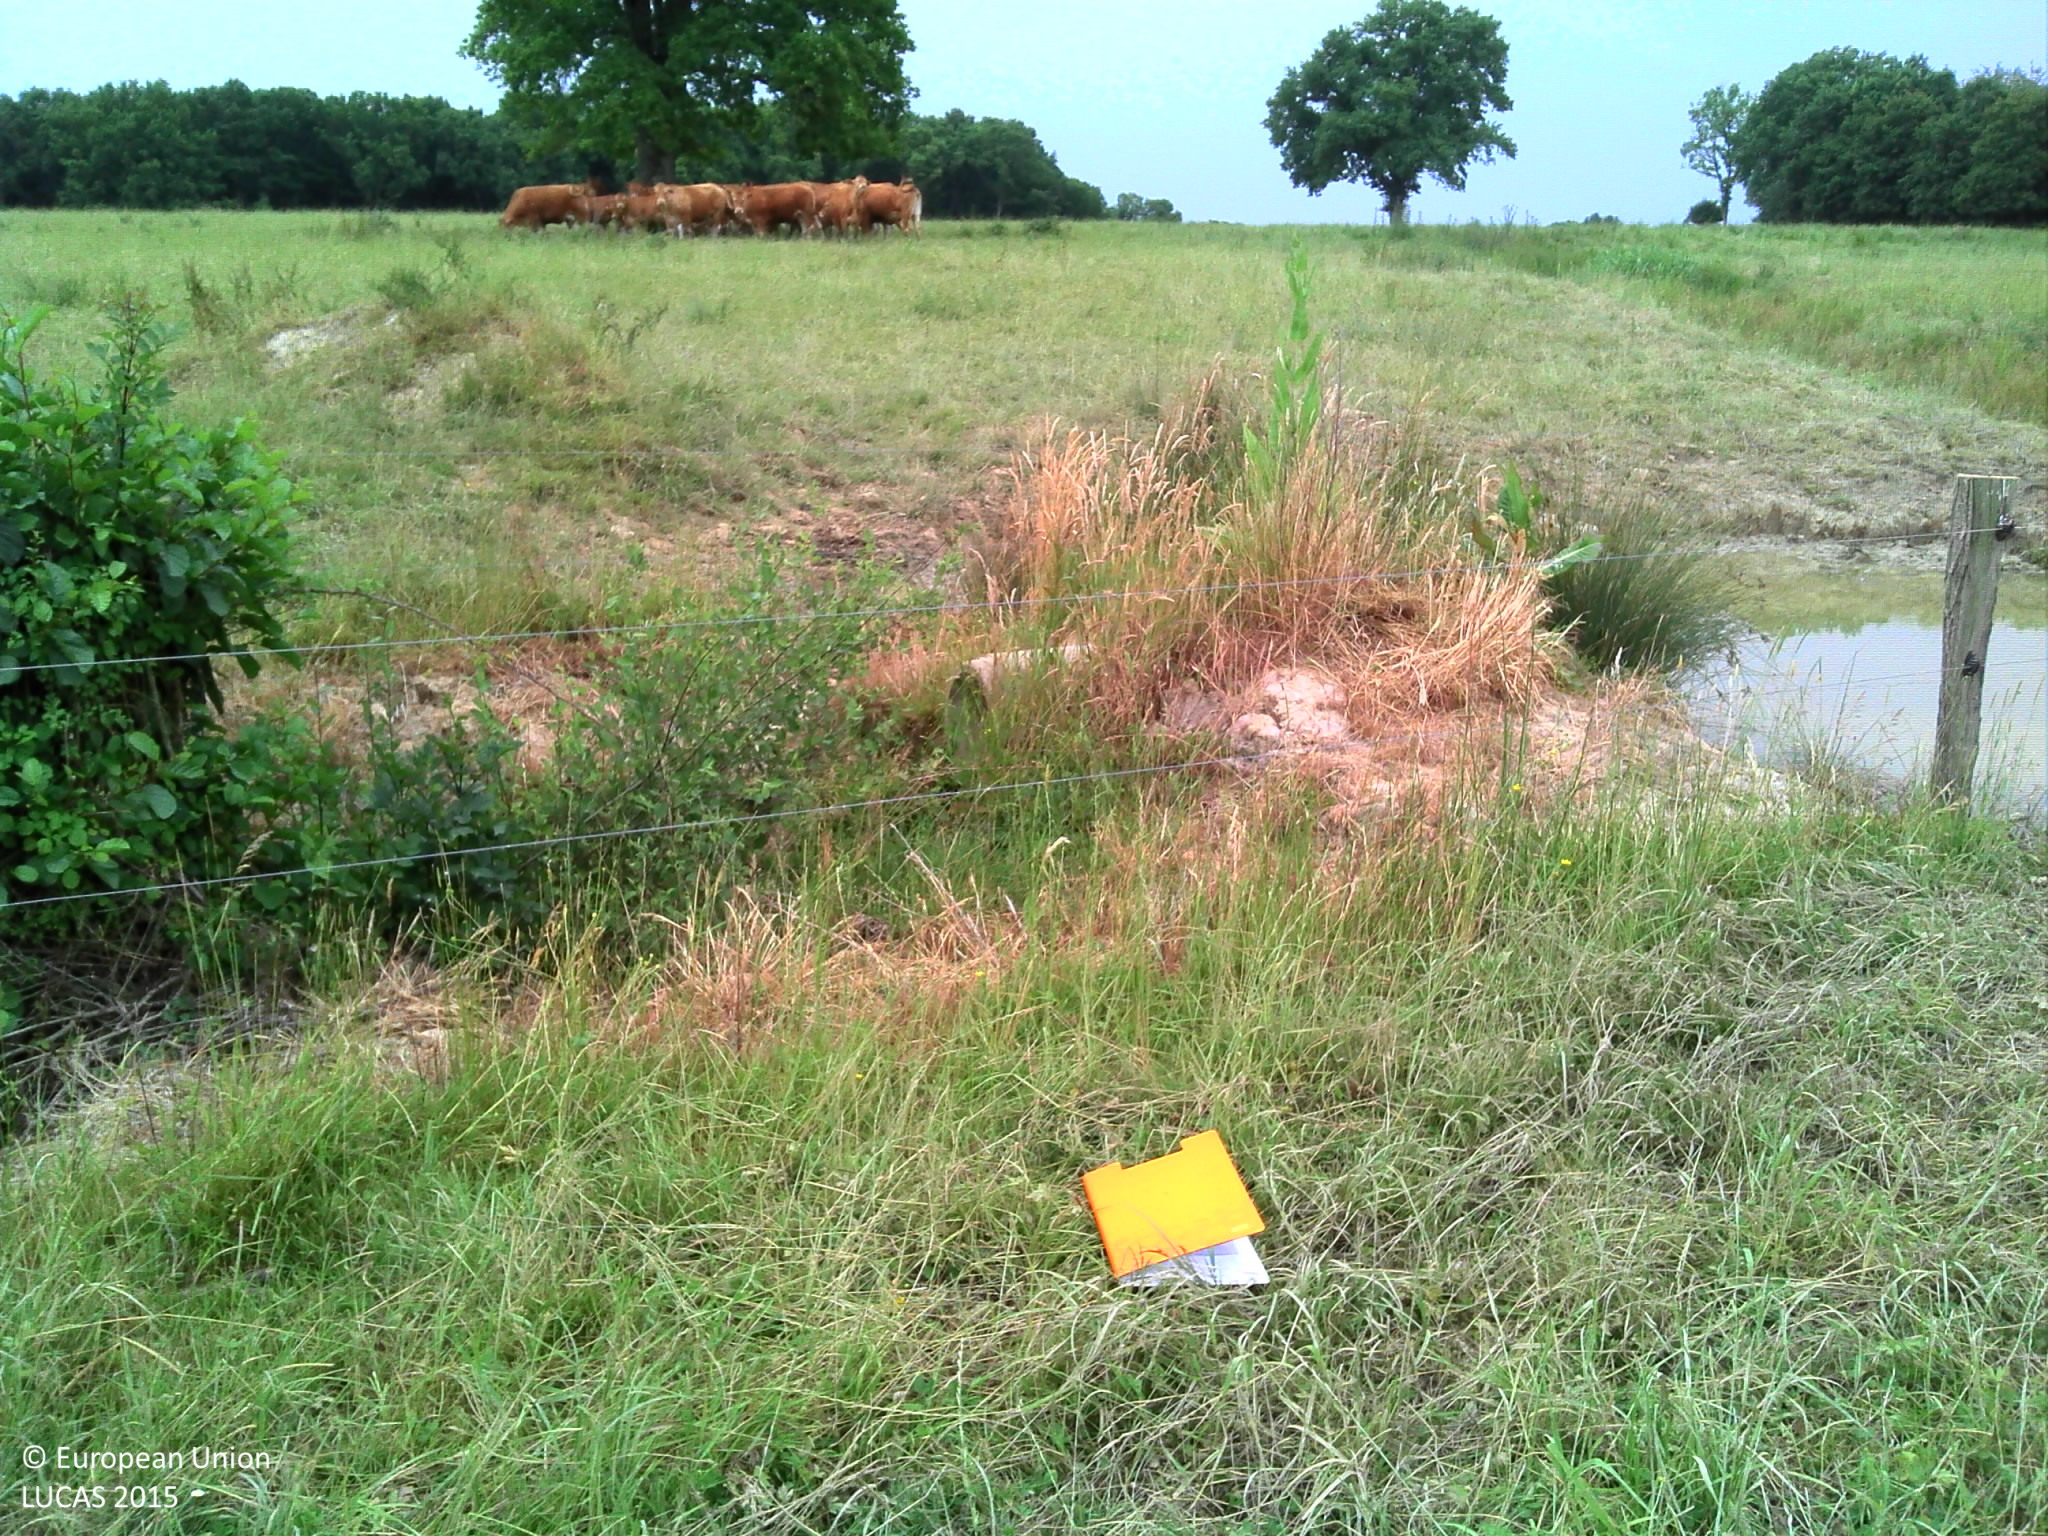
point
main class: Grassland
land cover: Grassland without tree/shrub cover
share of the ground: > 75 %
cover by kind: herbaceous plants 100 %
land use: Agriculture (excluding fallow land and kitchen gardens)
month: June
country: FR
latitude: 46.7689
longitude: 2.6750
